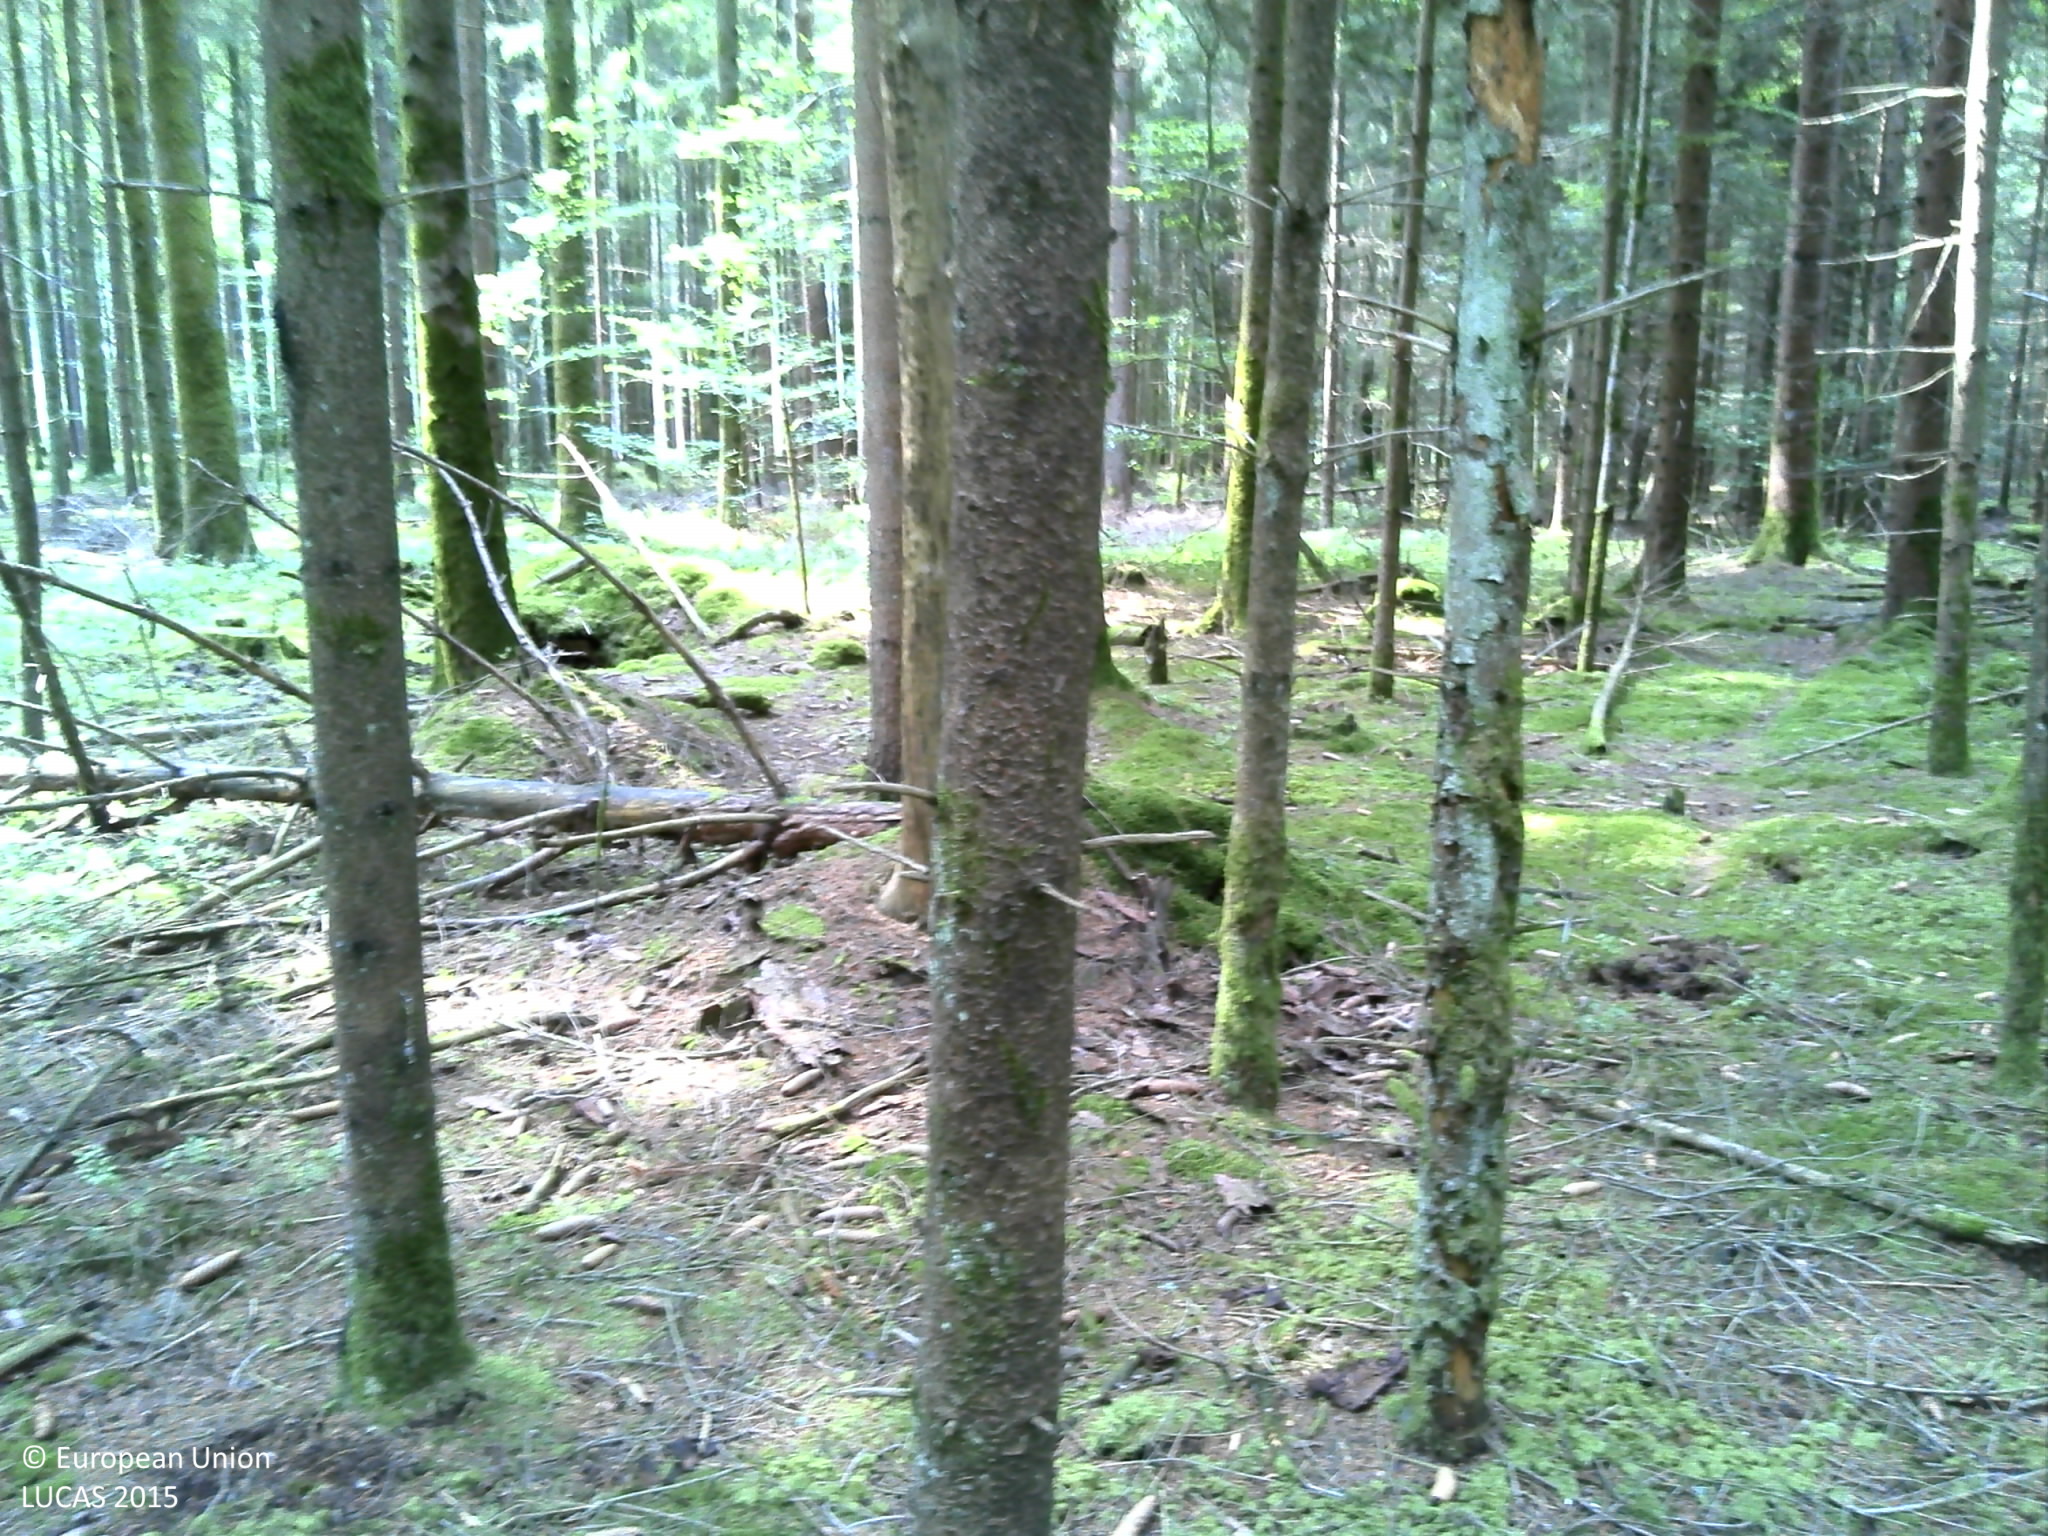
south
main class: Woodland
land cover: Spruce dominated coniferous woodland
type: exotic forest
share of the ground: > 75 %
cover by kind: coniferous forest trees 95 %, lichens and mosses 5 %
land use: Forestry
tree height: > 5 m
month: August
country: FR
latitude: 48.3393
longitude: 6.8034
